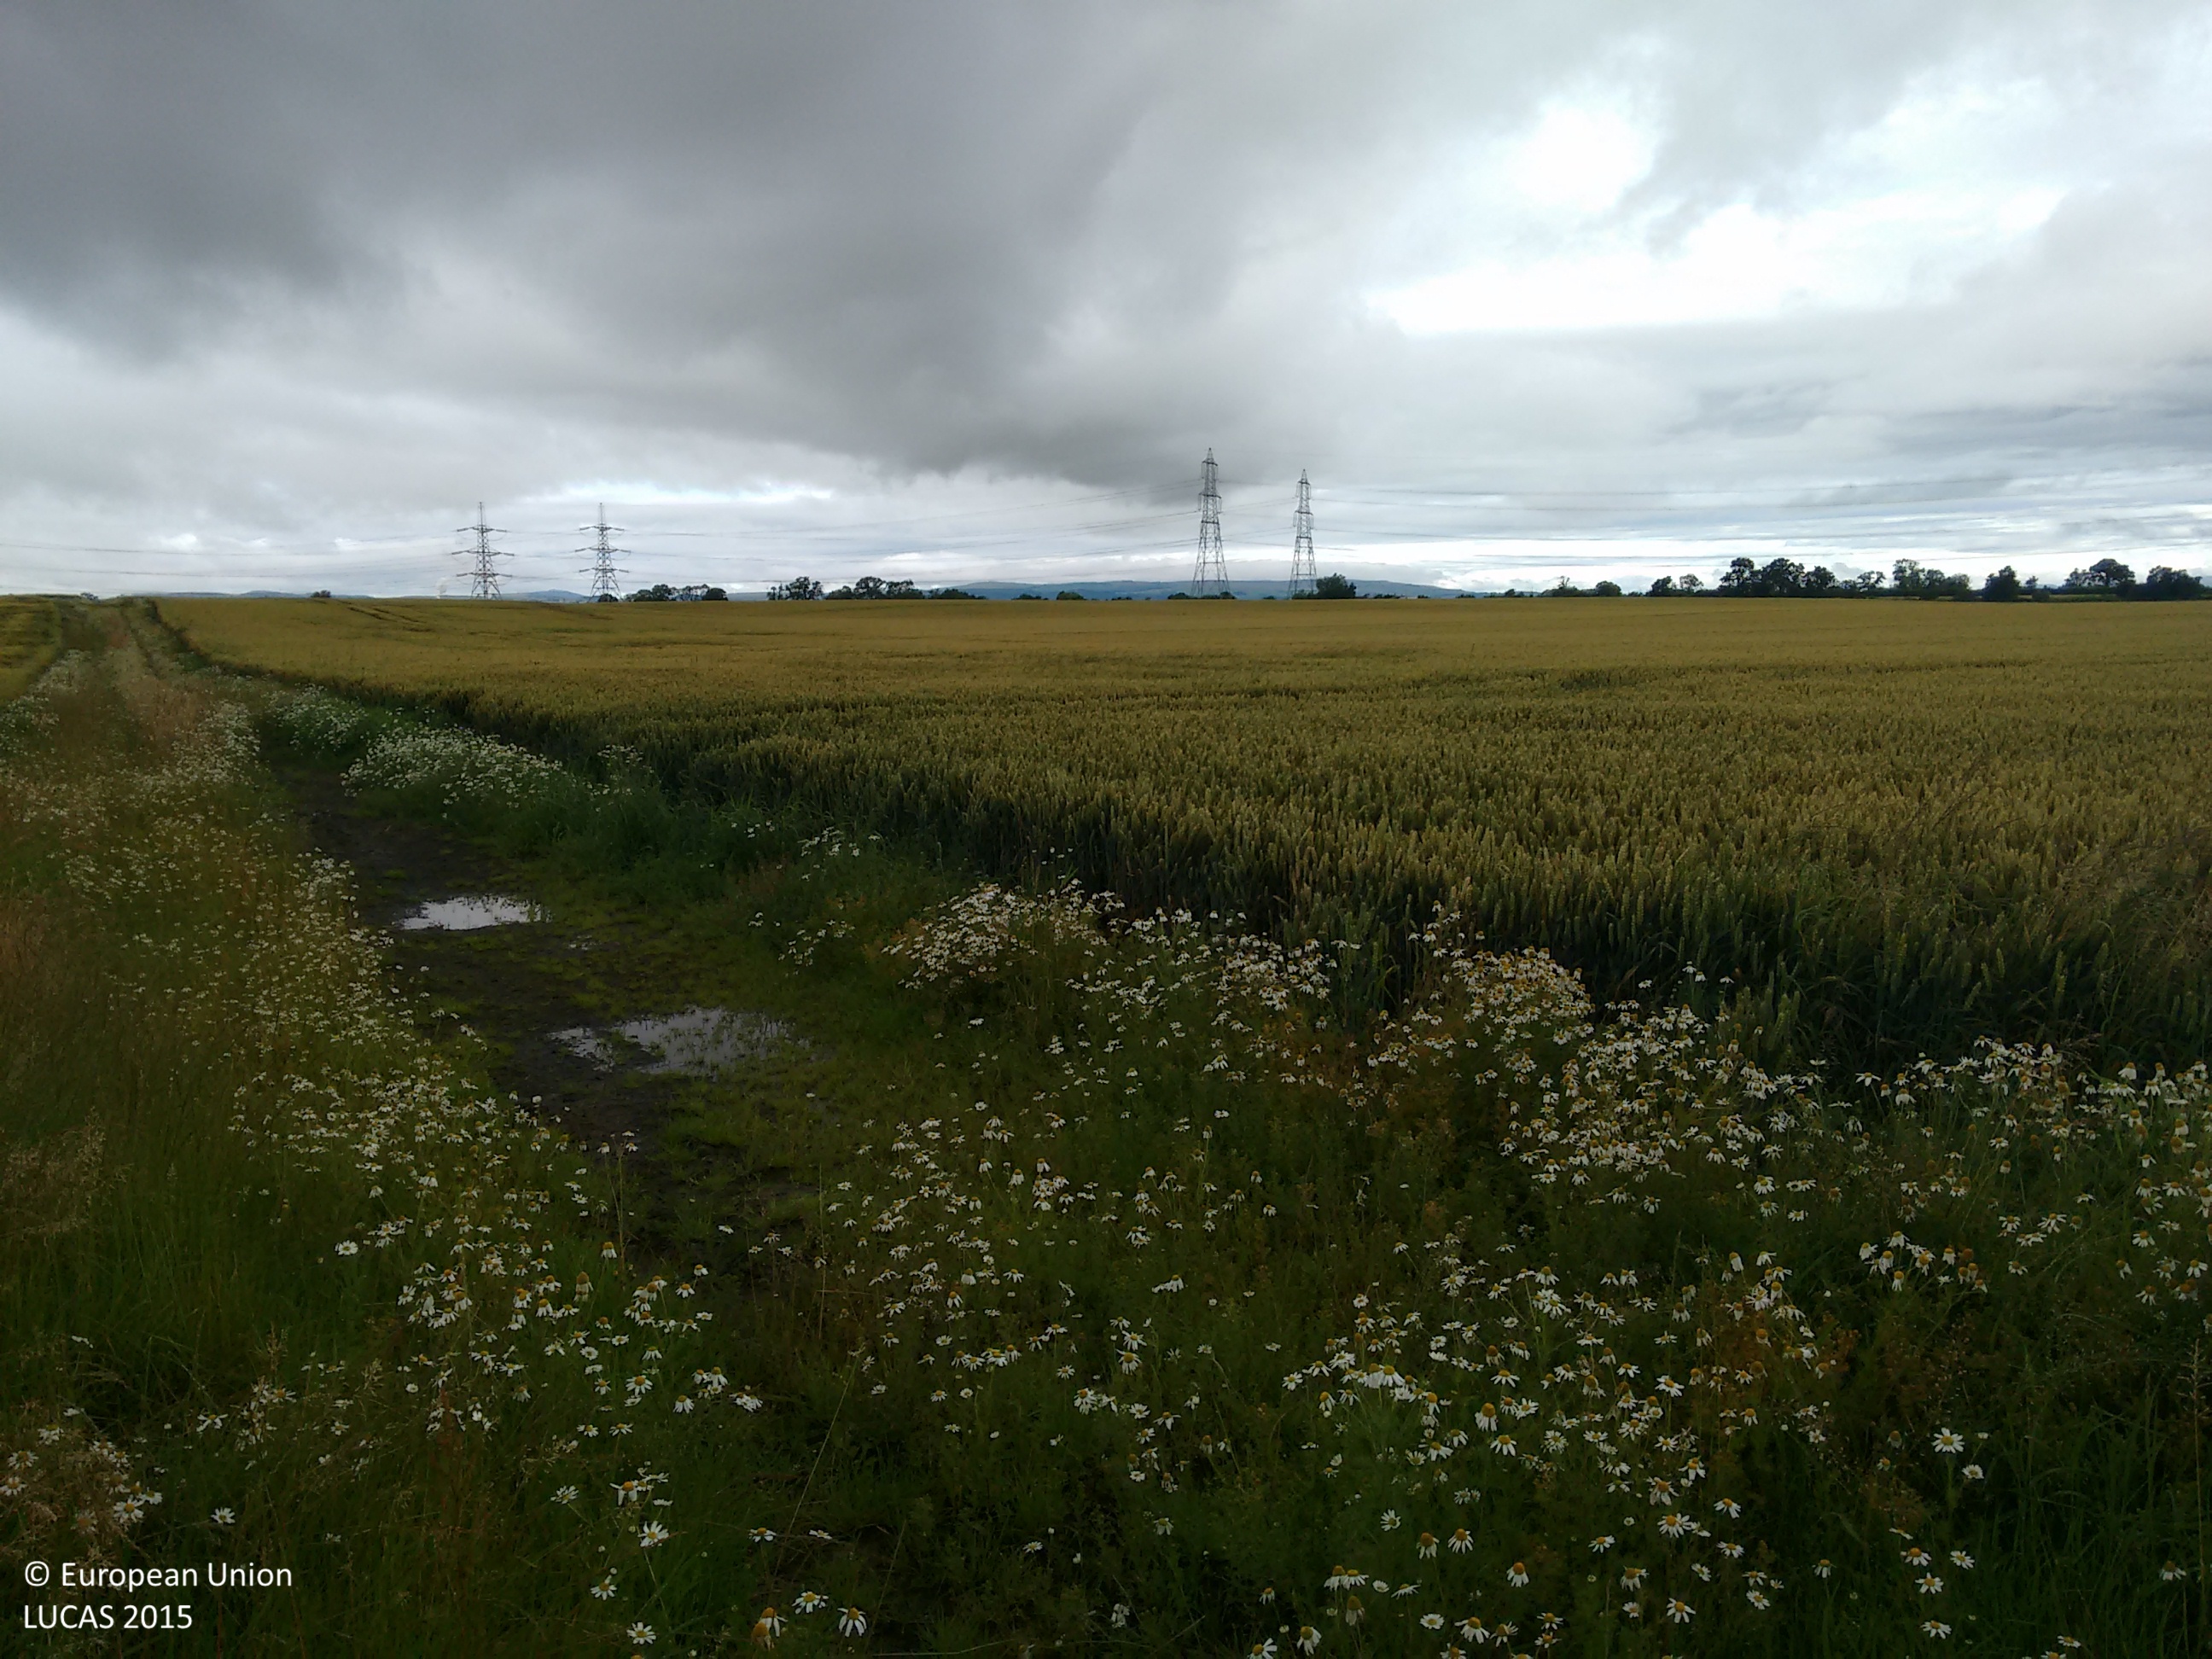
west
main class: Cropland
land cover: Barley
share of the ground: > 75 %
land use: Agriculture (excluding fallow land and kitchen gardens)
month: August
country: GB
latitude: 56.0957
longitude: -3.7942
